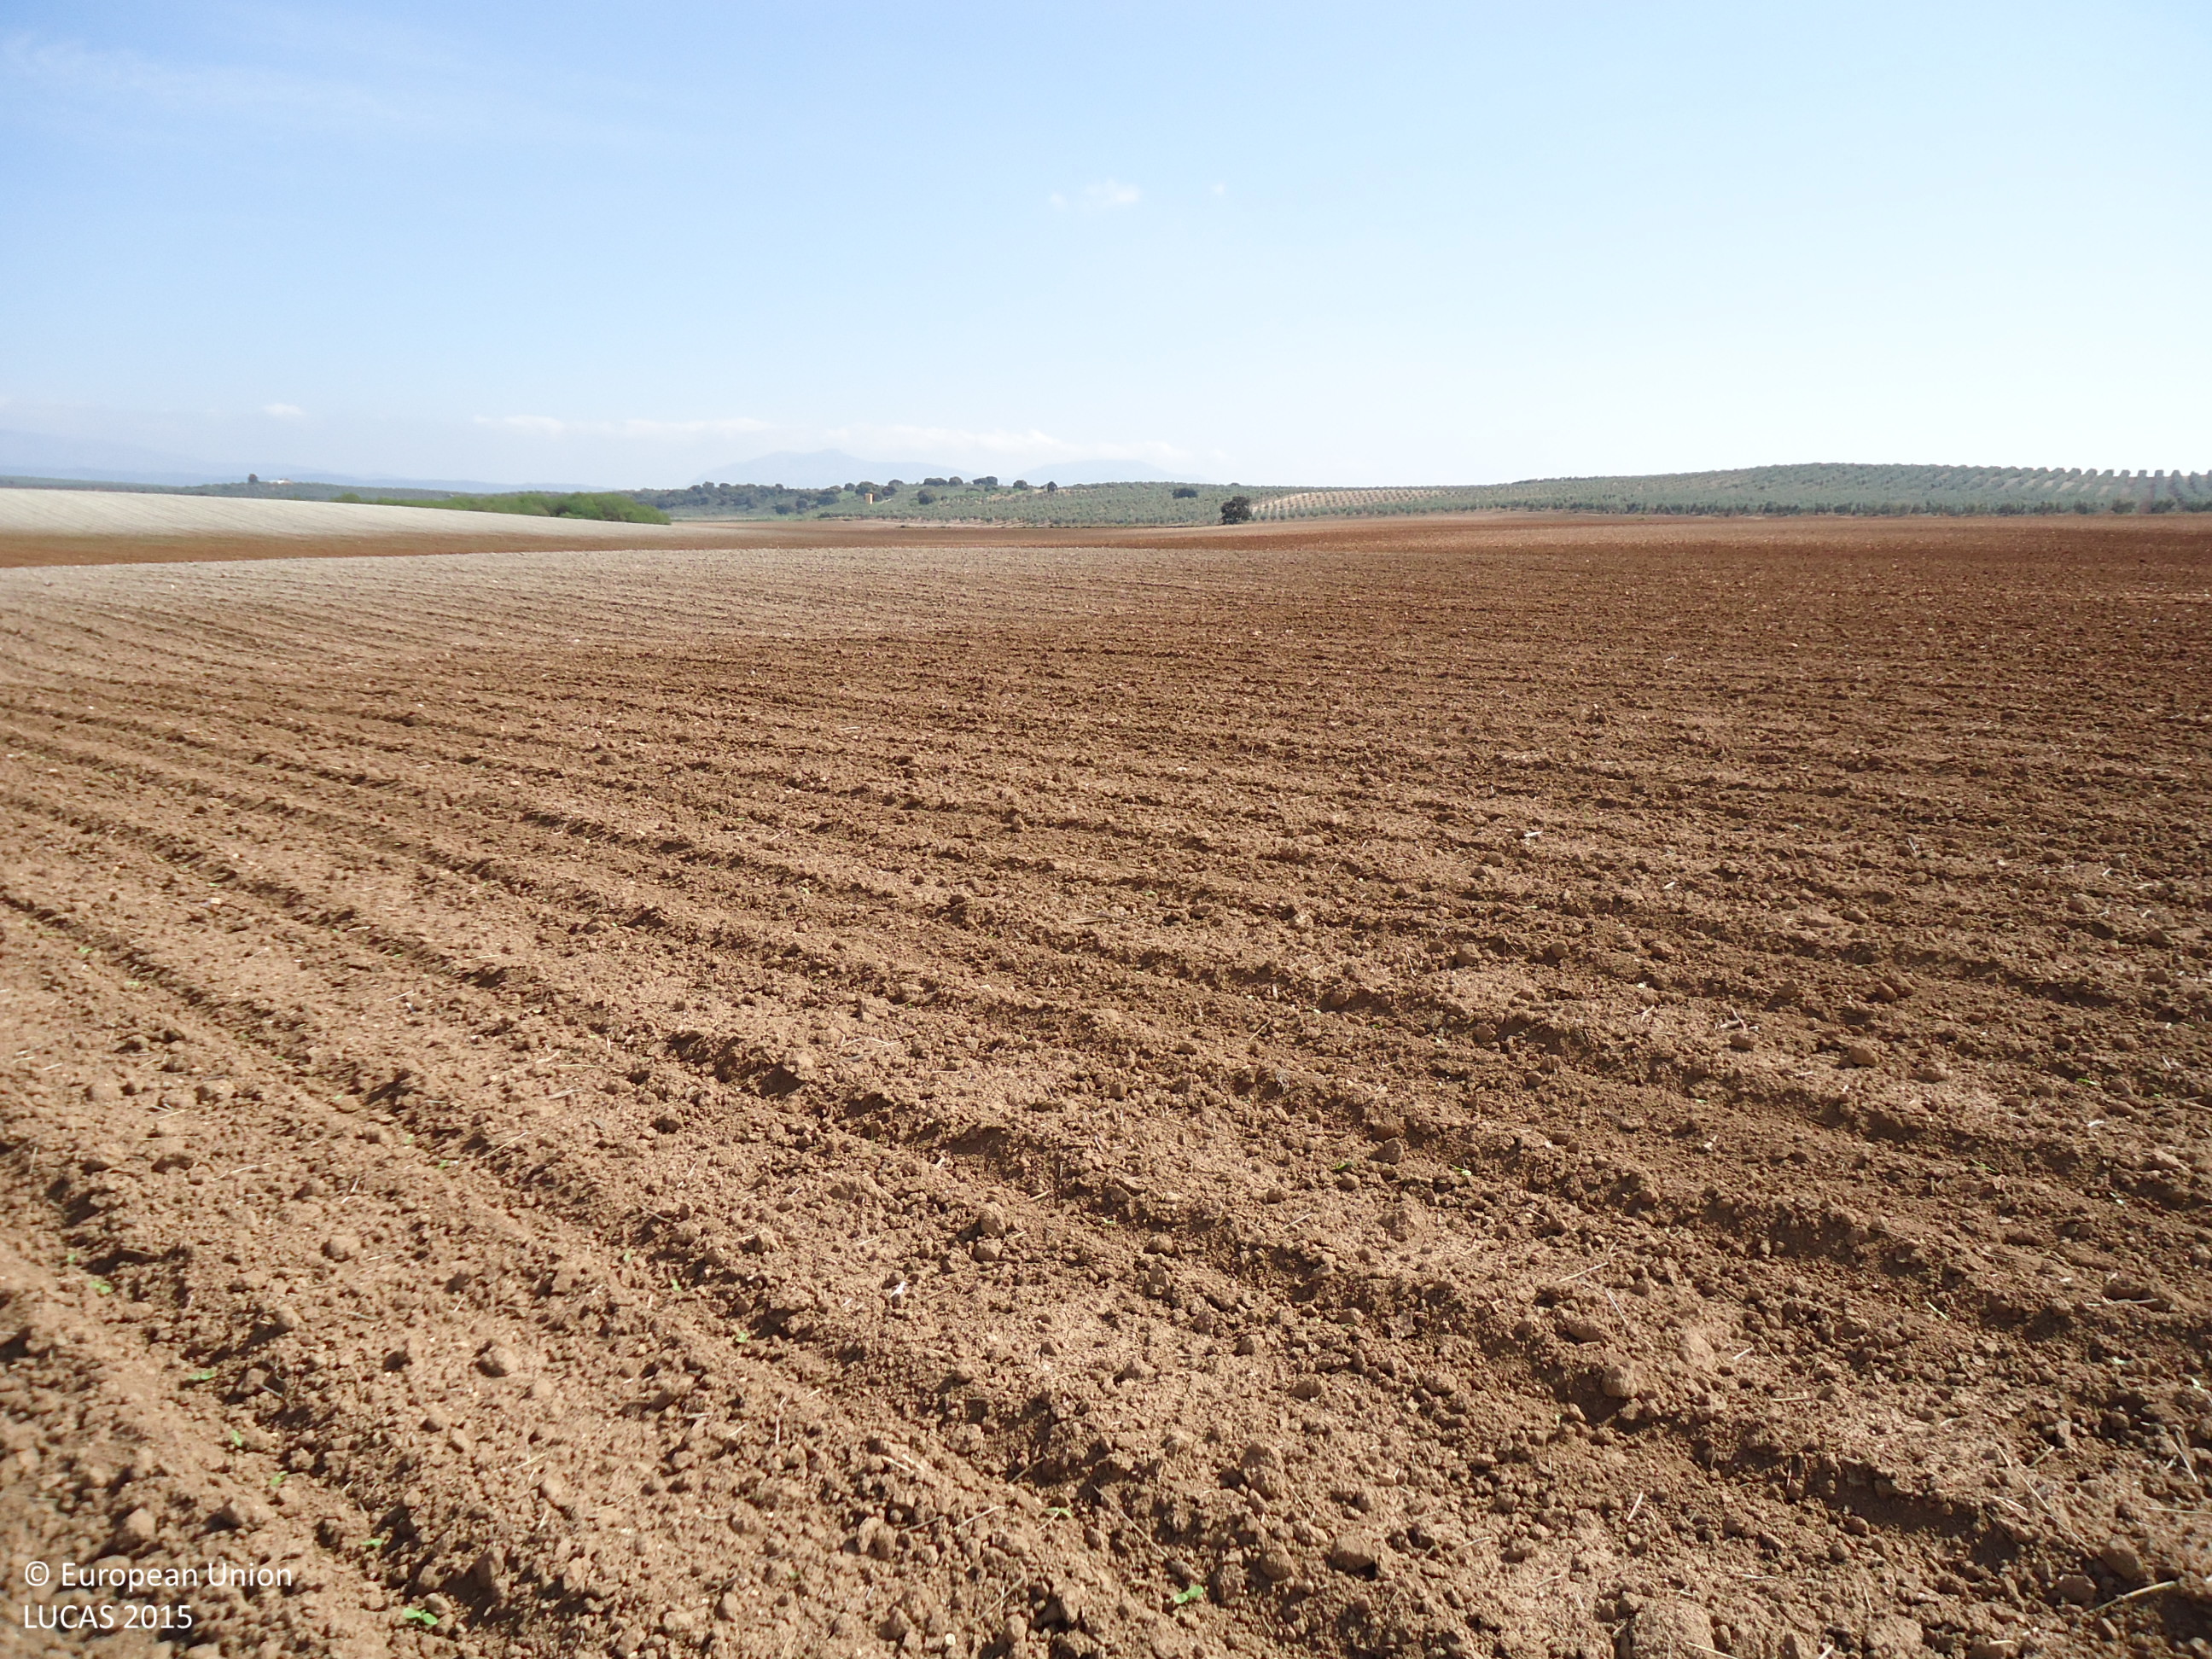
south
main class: Cropland
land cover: Sunflower
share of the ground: < 10 %
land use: Agriculture (excluding fallow land and kitchen gardens)
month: April
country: ES
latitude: 37.0983
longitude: -4.7967
